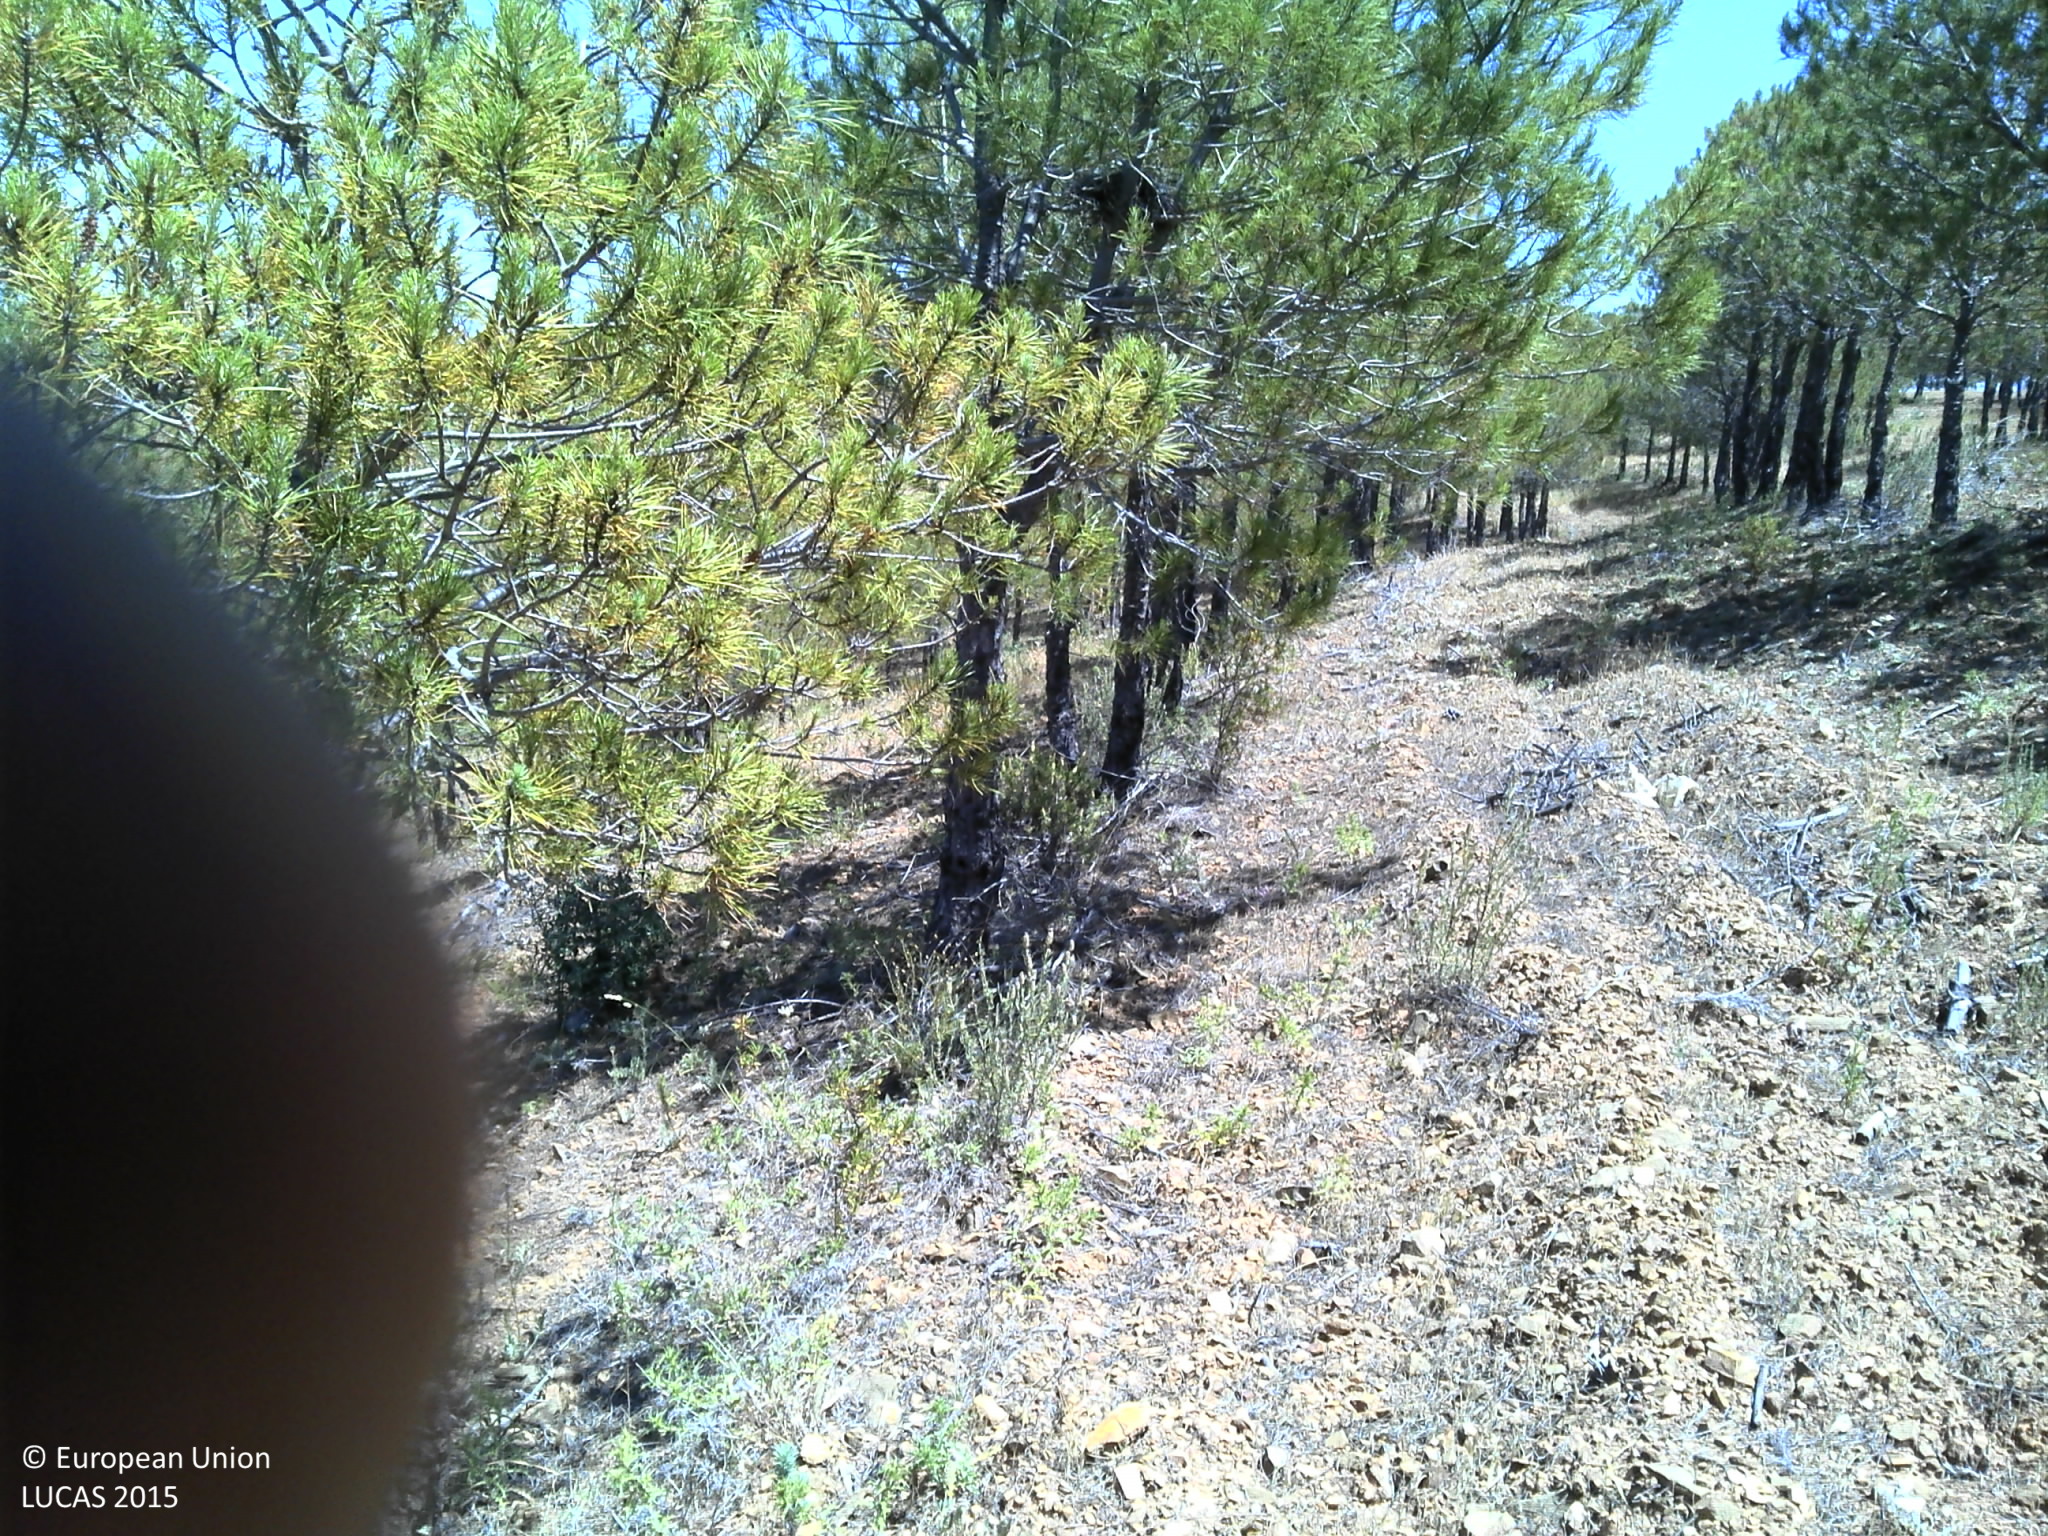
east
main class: Woodland
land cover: Pine dominated coniferous woodland
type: coniferous forest of the mediterranean region
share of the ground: 50 - 75 %
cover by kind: coniferous forest trees 65 %, unconsolidated bare surface 30 %, herbaceous plants 5 %
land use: Forestry
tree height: < 5 m
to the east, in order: Pine dominated coniferous woodland; Rivers and streams; Grassland without tree/shrub cover; Dry stone walls; Shruby margins; Tracks; Grassland with sparse tree/shrub cover; Grassland without tree/shrub cover; Shrubland without tree cover; Shrubland with sparse tree cover
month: May
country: PT
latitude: 37.3651
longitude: -7.5196
